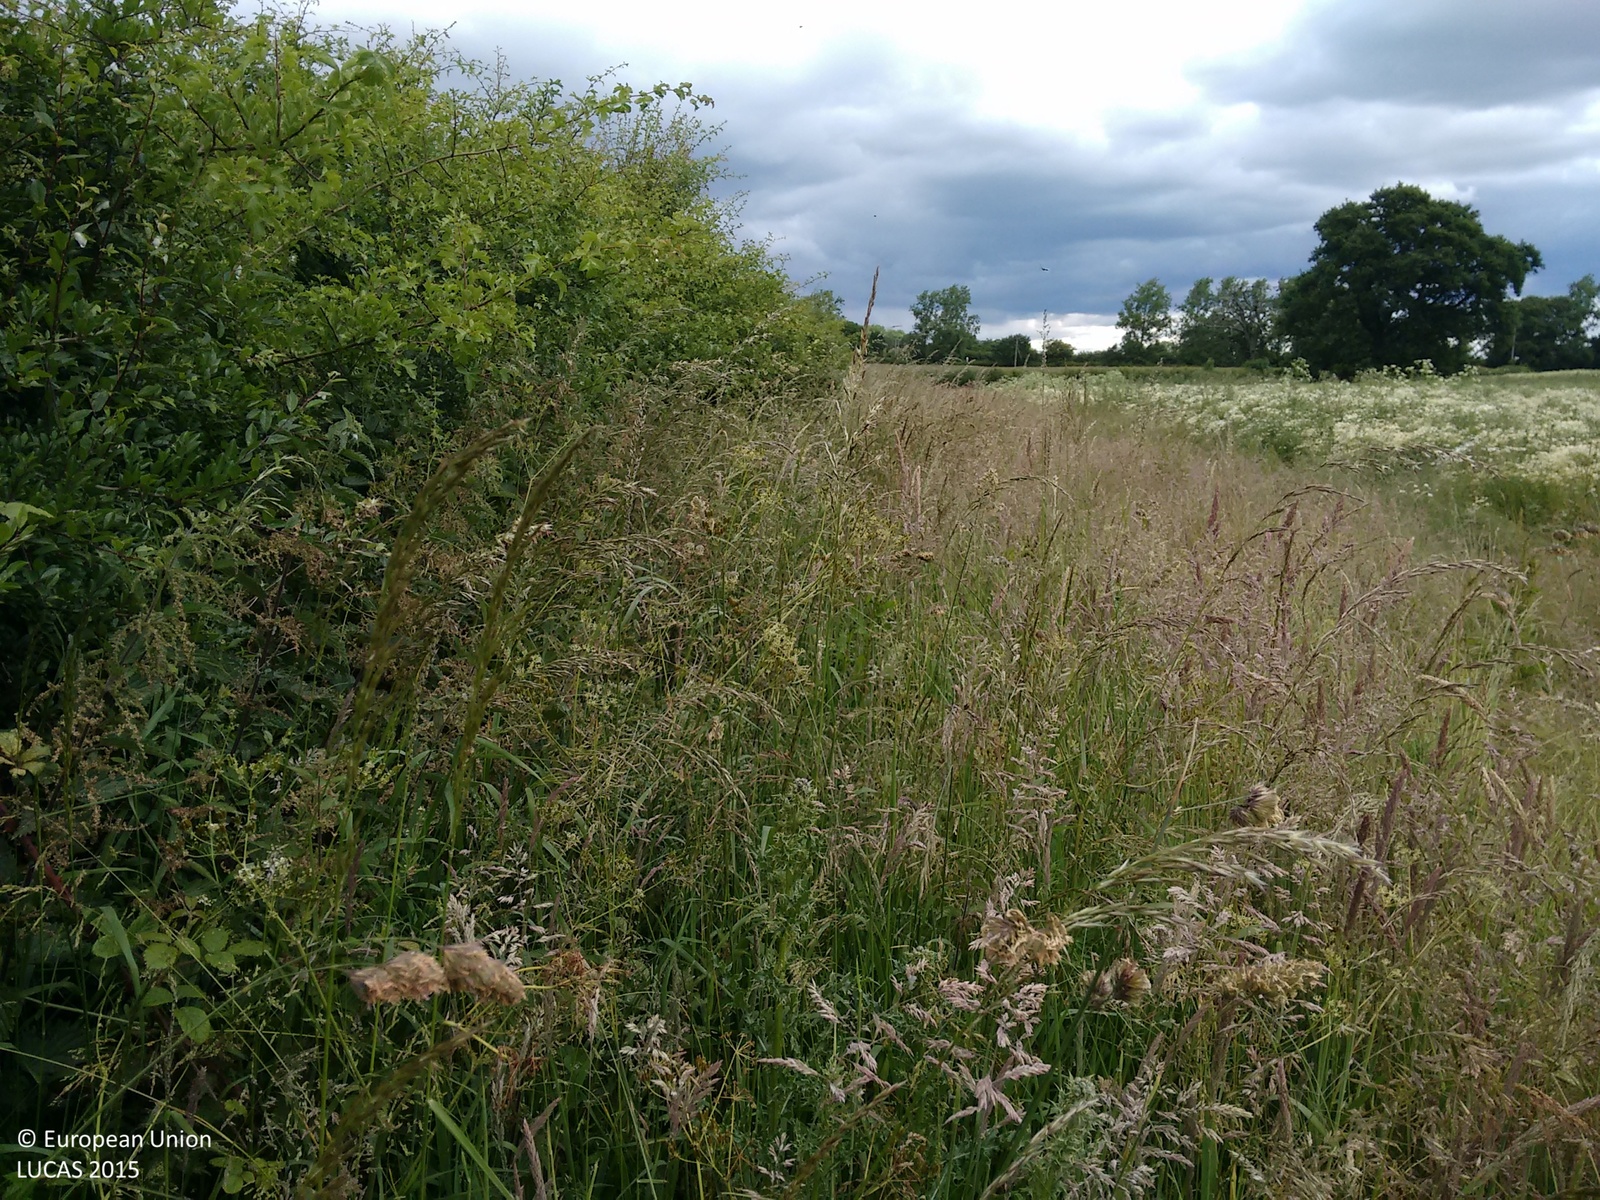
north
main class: Grassland
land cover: Grassland without tree/shrub cover
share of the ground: > 75 %
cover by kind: herbaceous plants 100 %
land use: Agriculture (excluding fallow land and kitchen gardens)
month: June
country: GB
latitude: 52.2307
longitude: -1.9017
